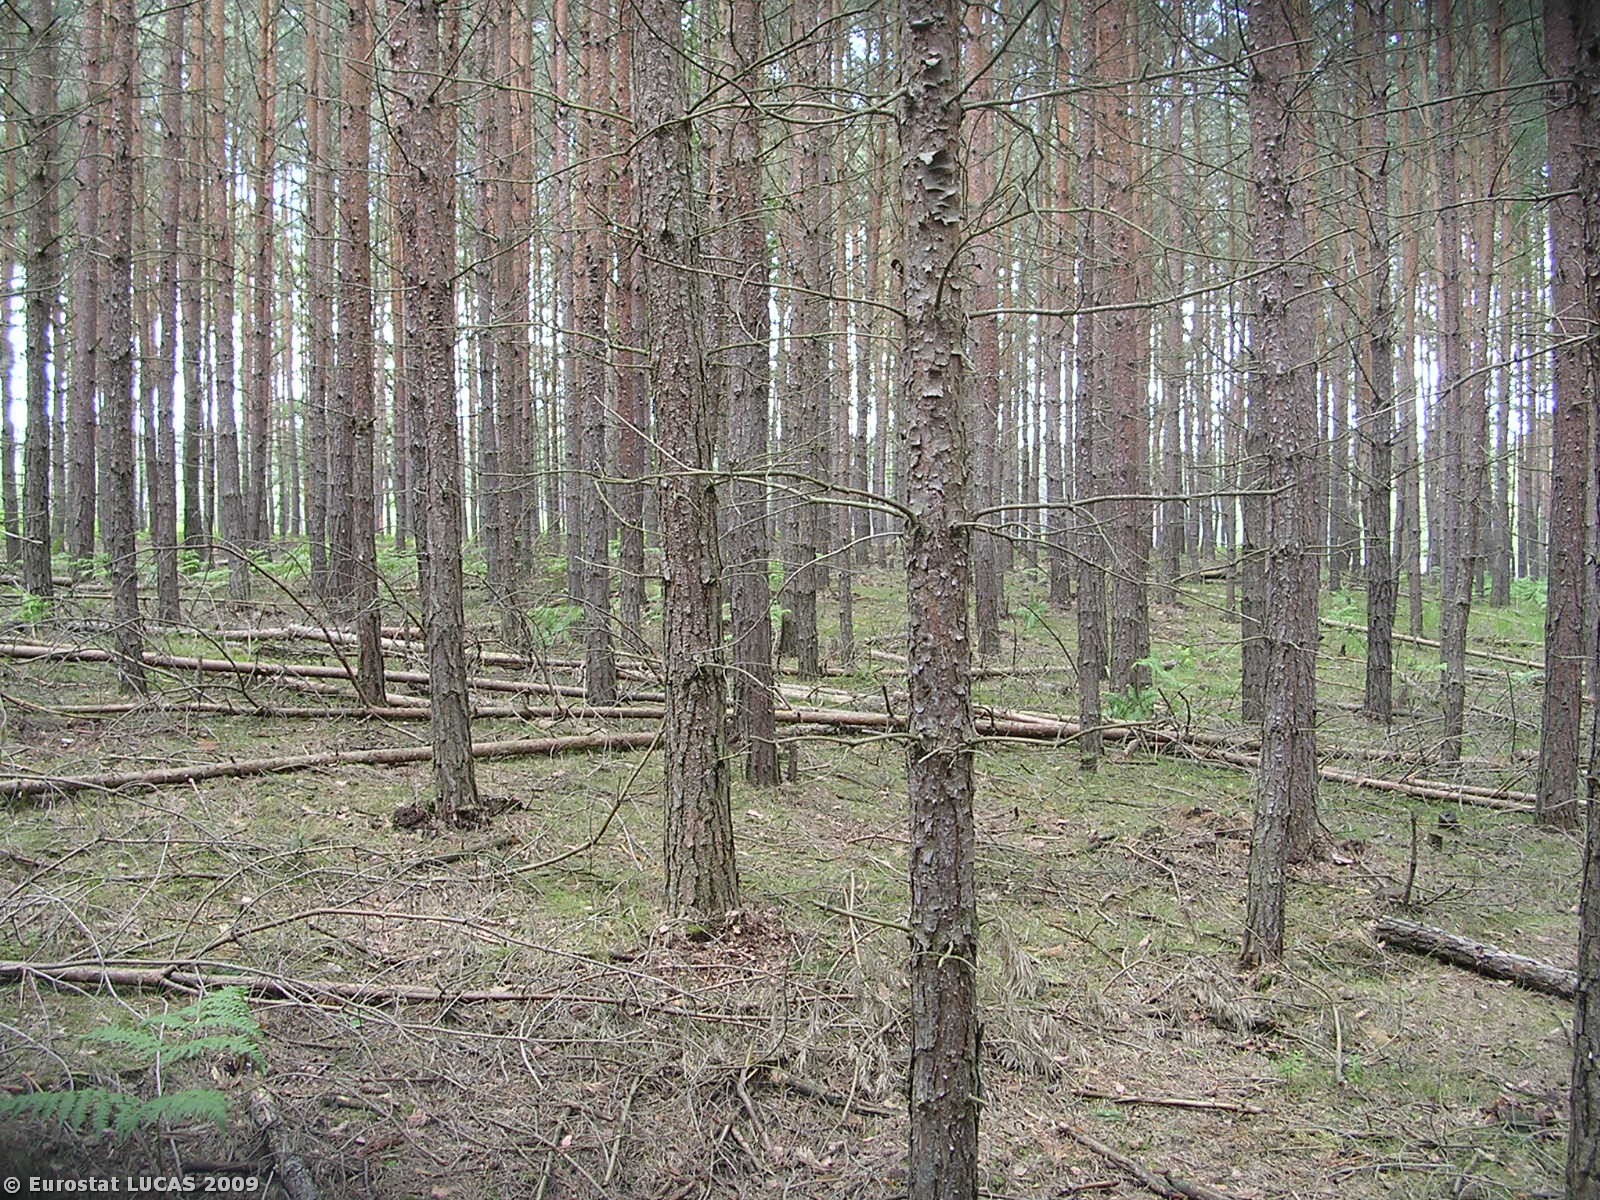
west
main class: Woodland
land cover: Coniferous woodland
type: hemiboreal forest and nemoral coniferous forest and mixed broadleaved-coniferous forest
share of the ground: > 75 %
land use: Forestry
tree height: > 5 m
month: June
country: CZ
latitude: 50.5544
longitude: 14.7307
